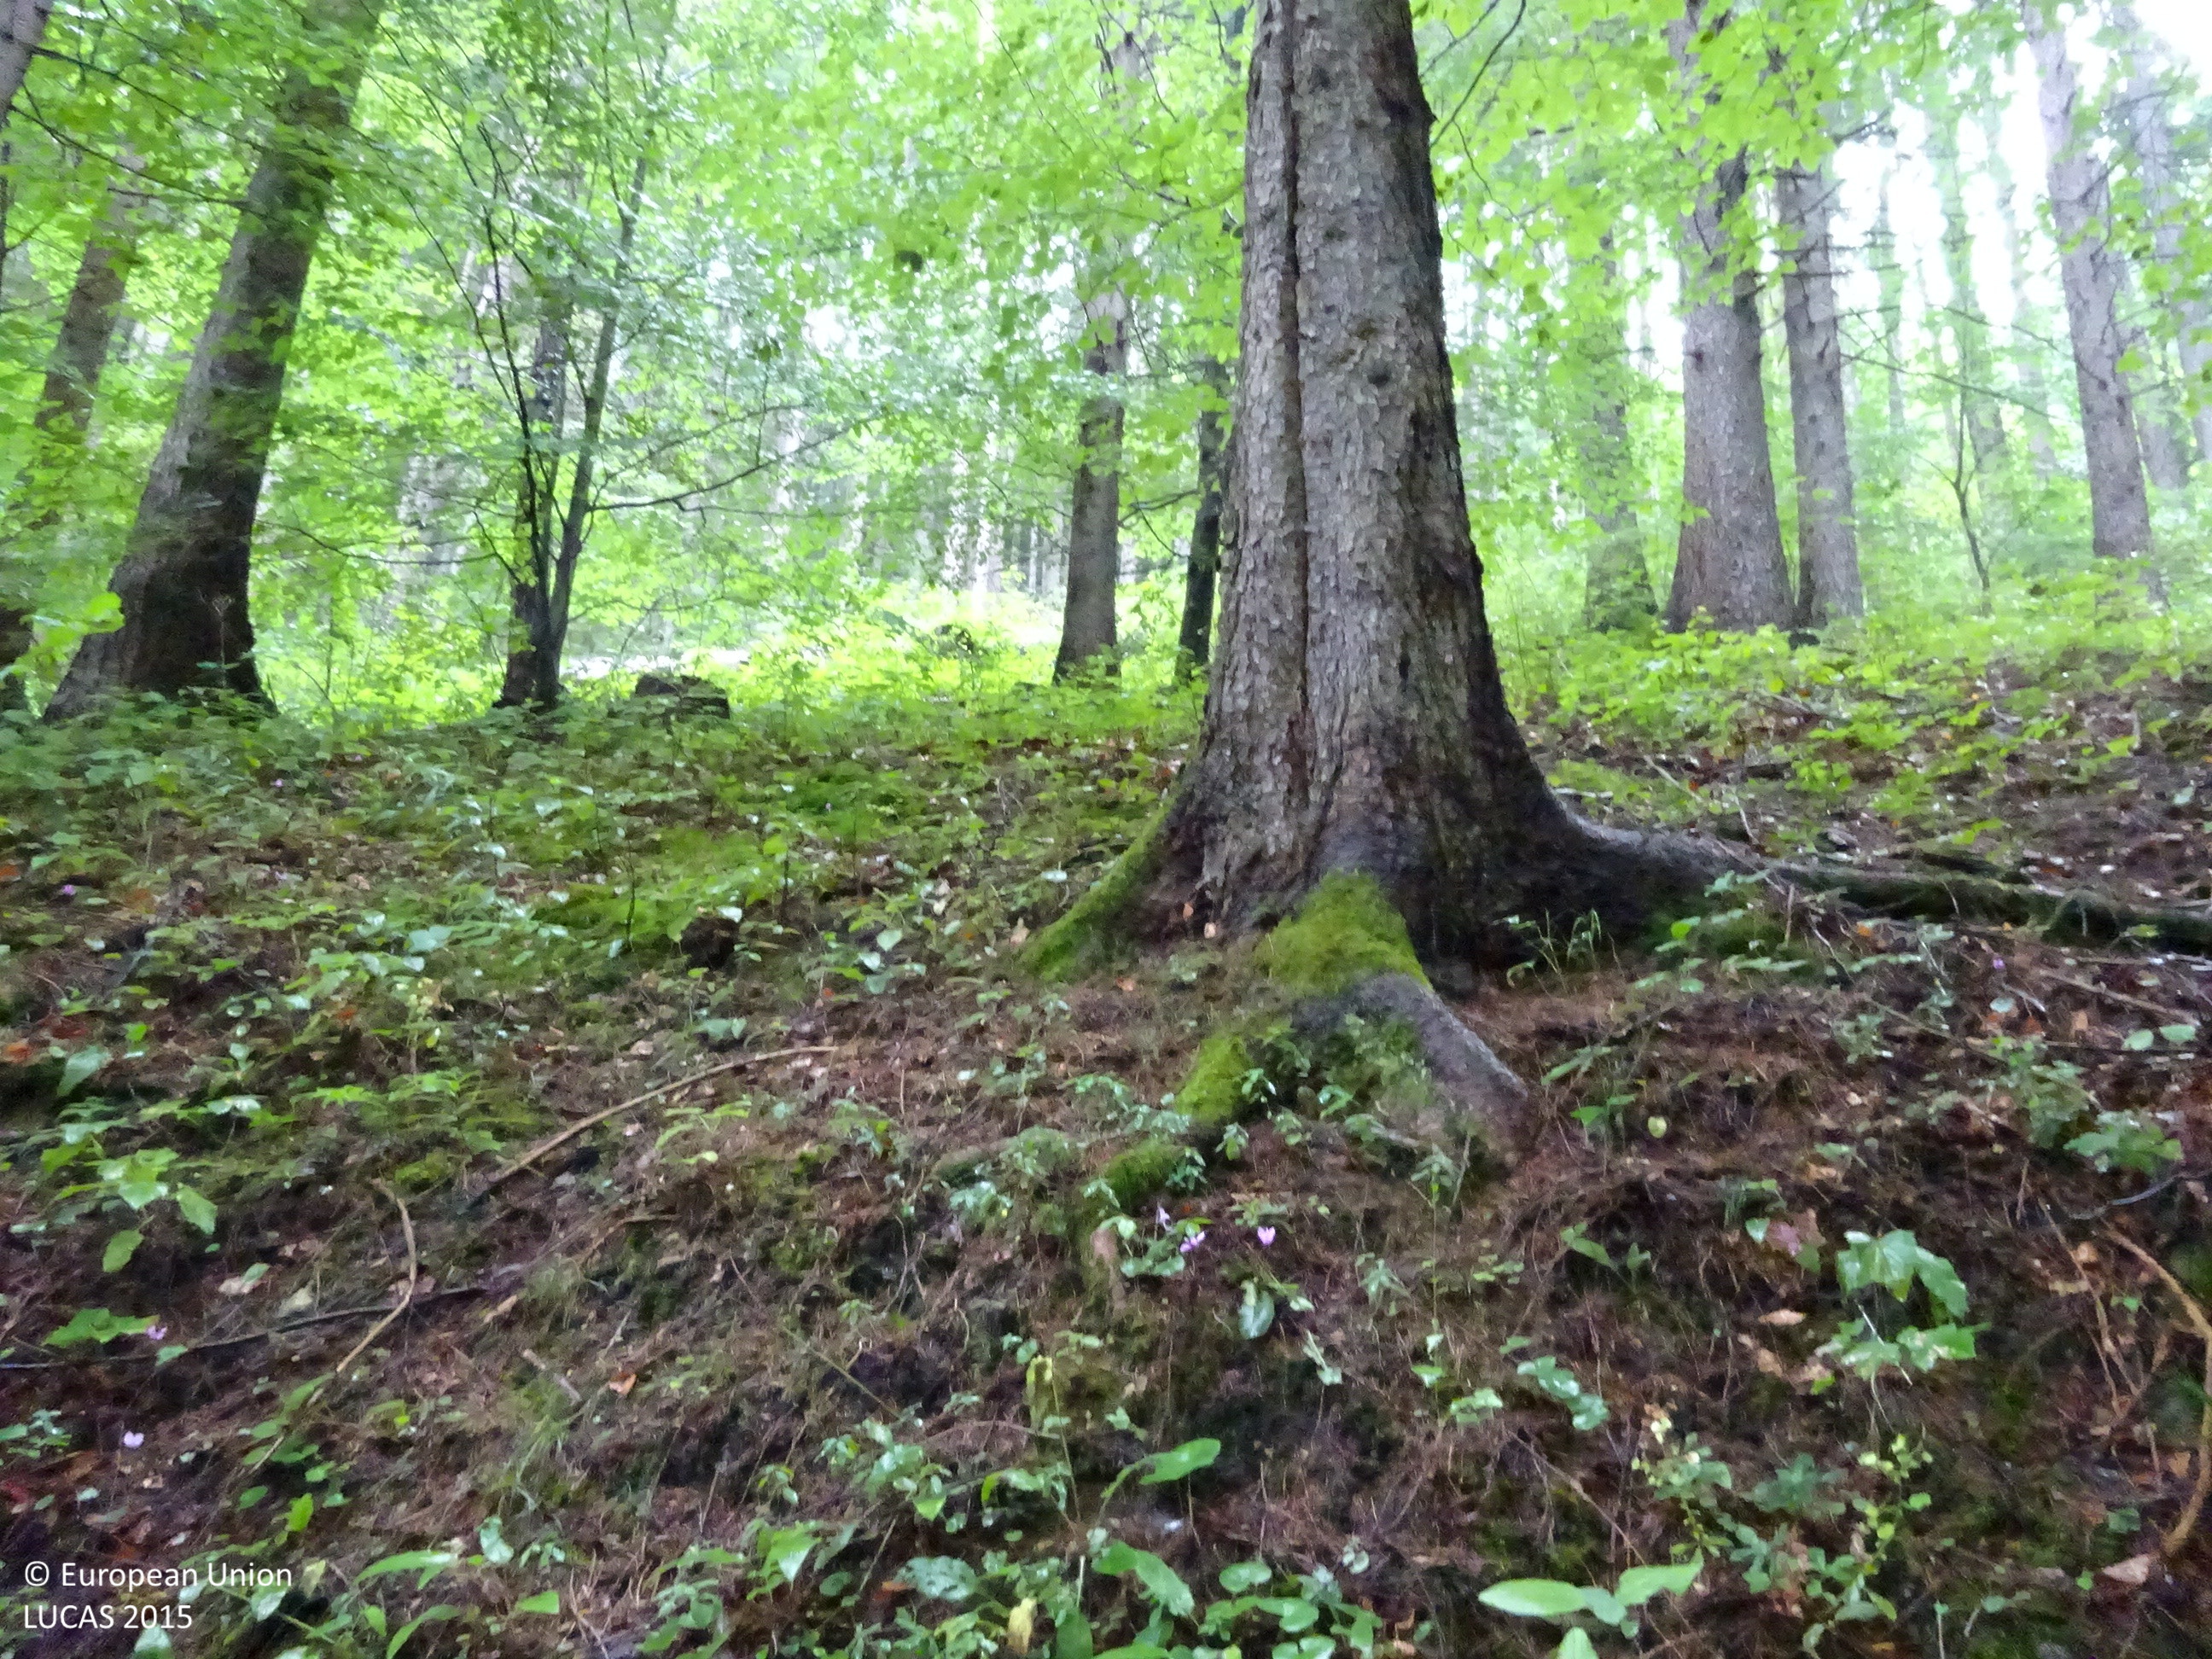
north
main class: Woodland
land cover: Spruce dominated mixed woodland
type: mountainous beech forest
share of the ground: > 75 %
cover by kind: coniferous forest trees 55 %, broadleaved forest trees 35 %, herbaceous plants 5 %, lichens and mosses 5 %
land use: Forestry
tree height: > 5 m
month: July
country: AT
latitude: 47.3164
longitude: 15.3846
